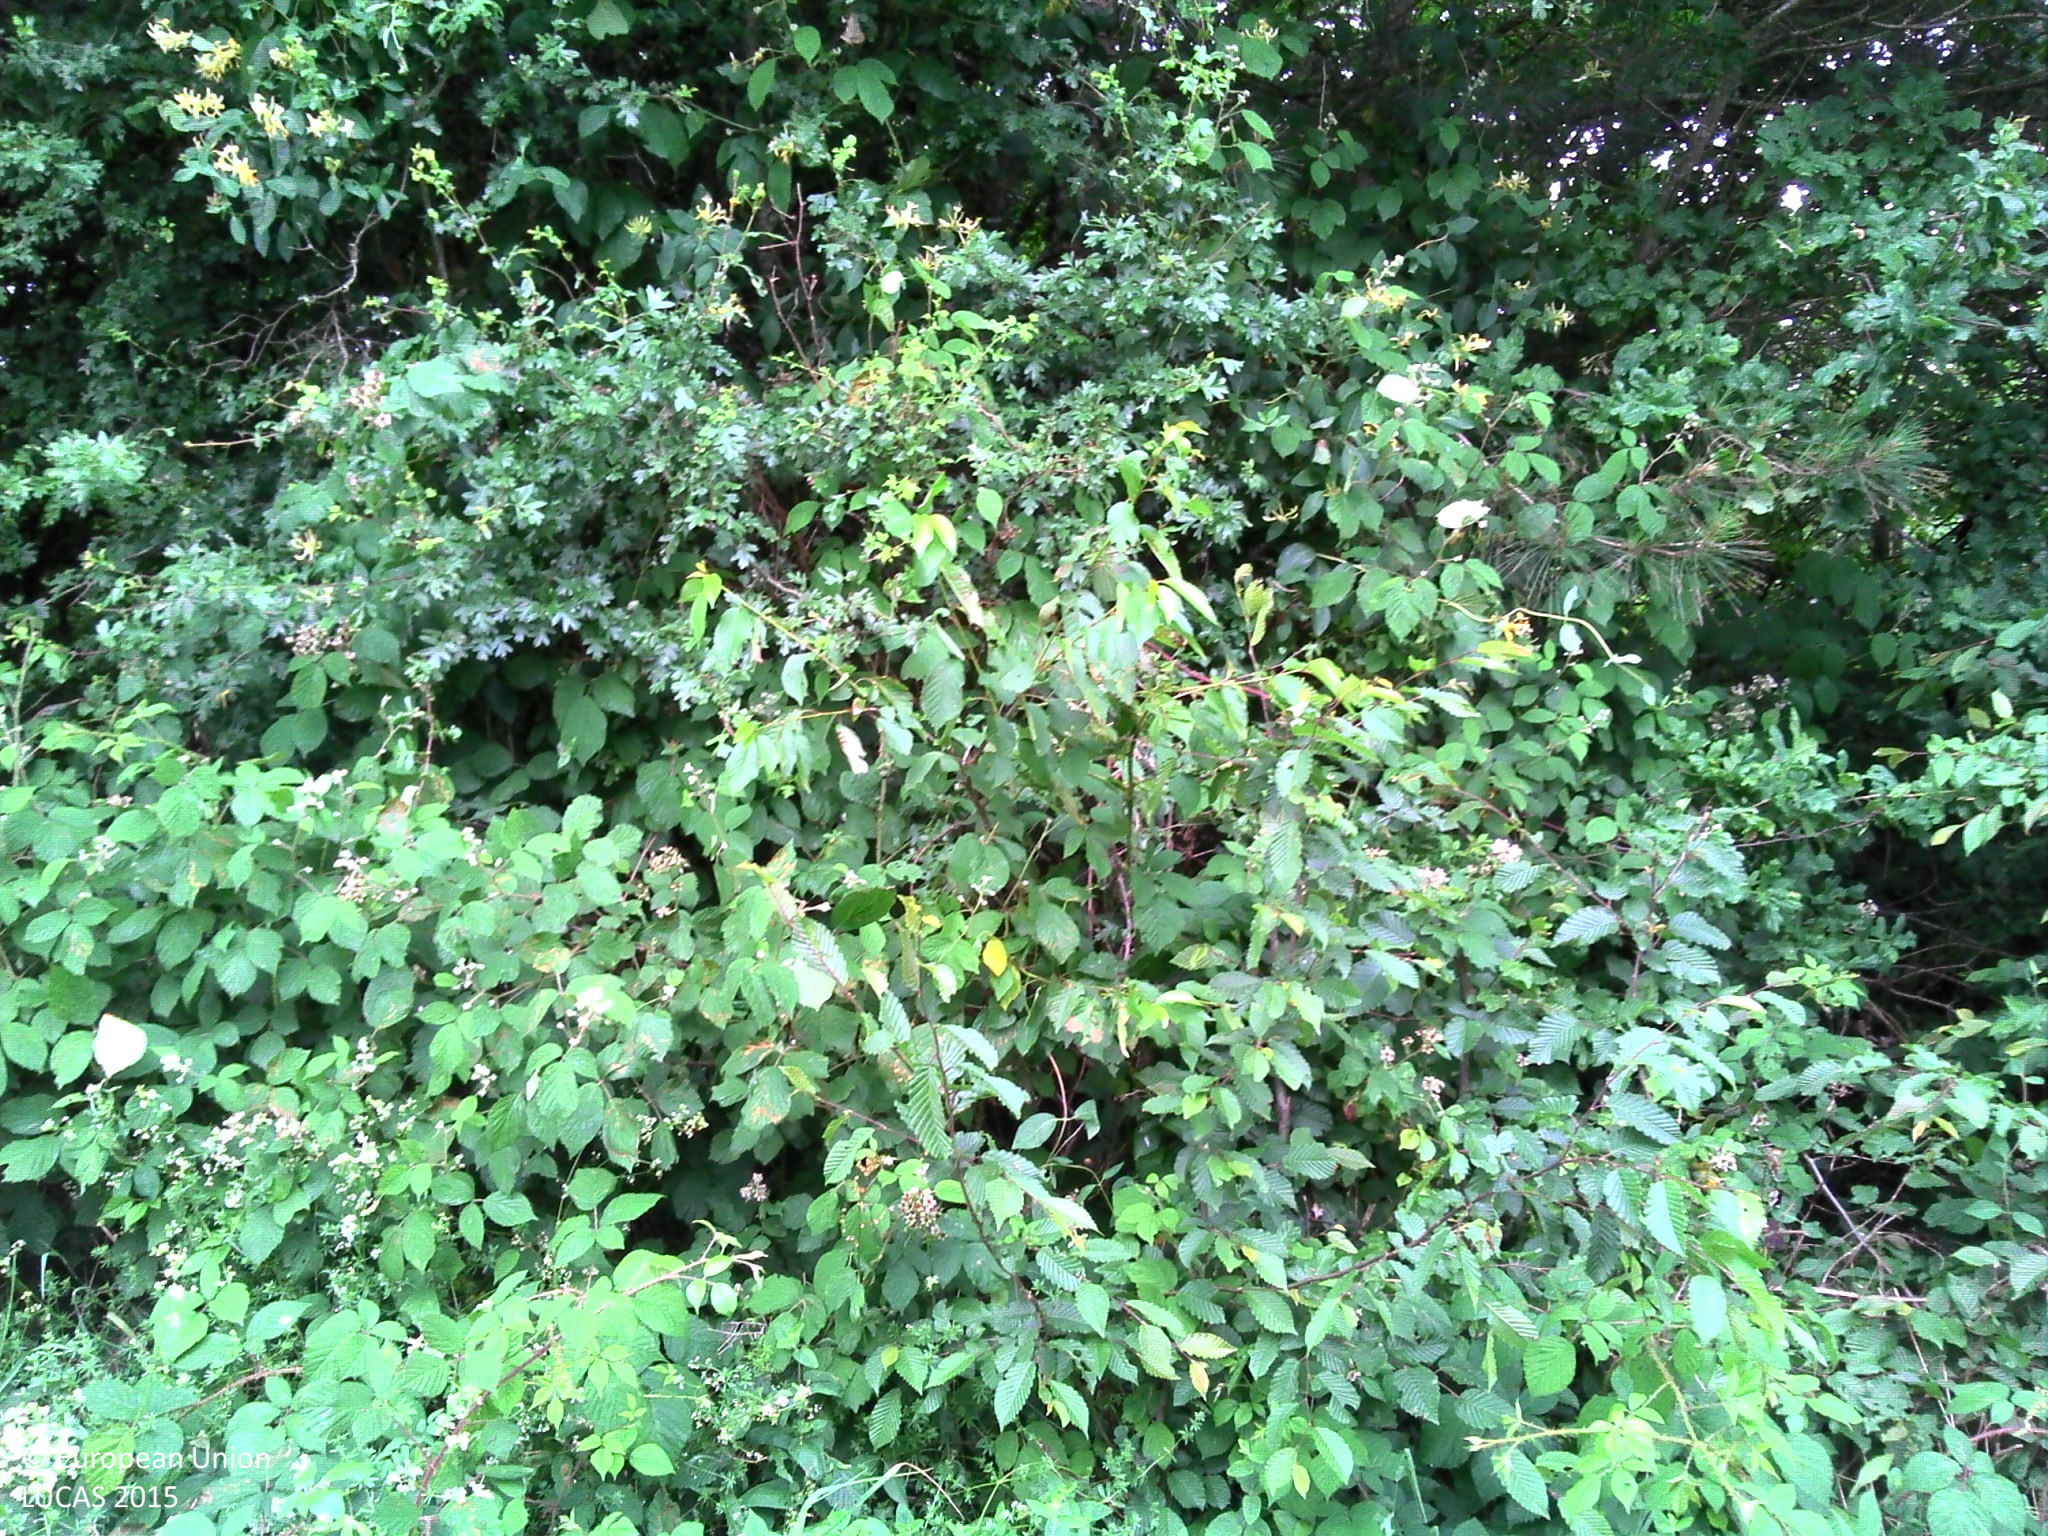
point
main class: Woodland
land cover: Broadleaved woodland
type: mesophytic deciduous forest
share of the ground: > 75 %
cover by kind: broadleaved forest trees 90 %, shrubs 5 %, herbaceous plants 5 %
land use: Forestry
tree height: > 5 m
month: June
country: FR
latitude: 46.3042
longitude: 3.0256
